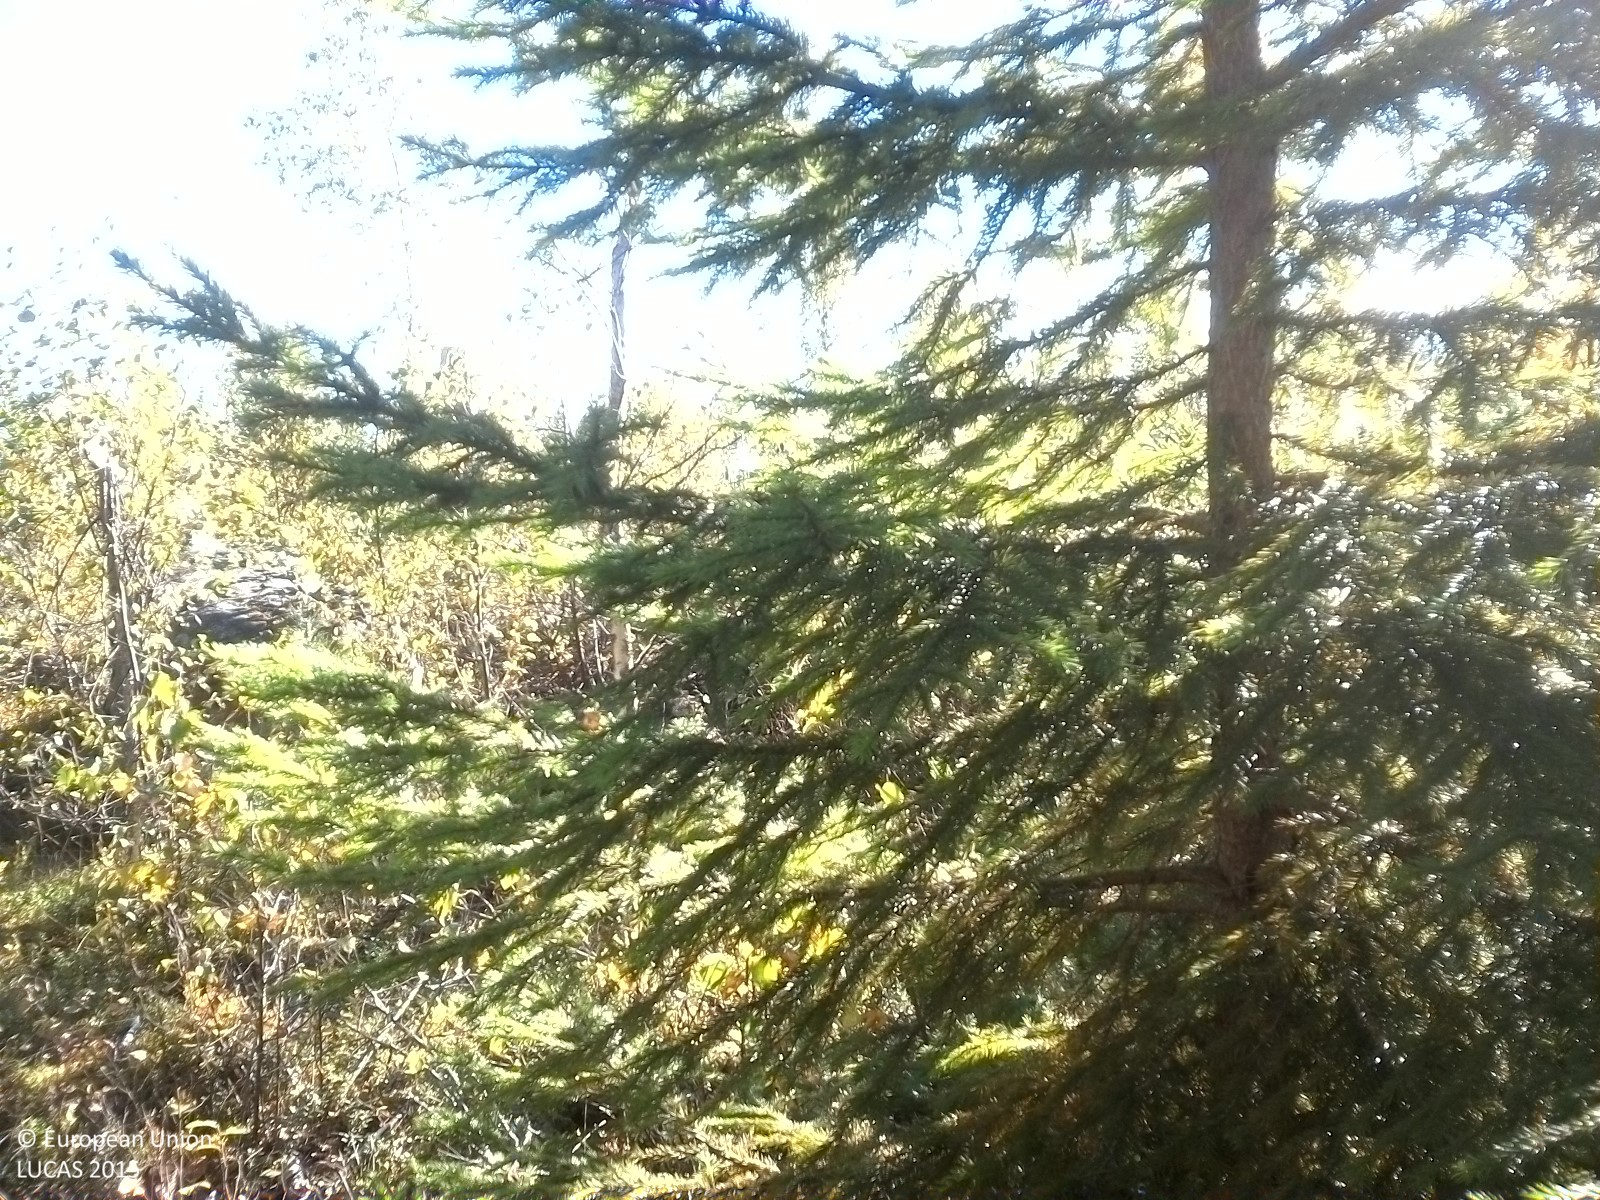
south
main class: Woodland
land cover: Spruce dominated mixed woodland
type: boreal forest
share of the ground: 25 - 50 %
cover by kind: herbaceous plants 35 %, coniferous forest trees 20 %, broadleaved forest trees 20 %, lichens and mosses 15 %, shrubs 10 %
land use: Forestry
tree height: < 5 m
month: September
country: SE
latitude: 58.7495
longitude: 16.4759
